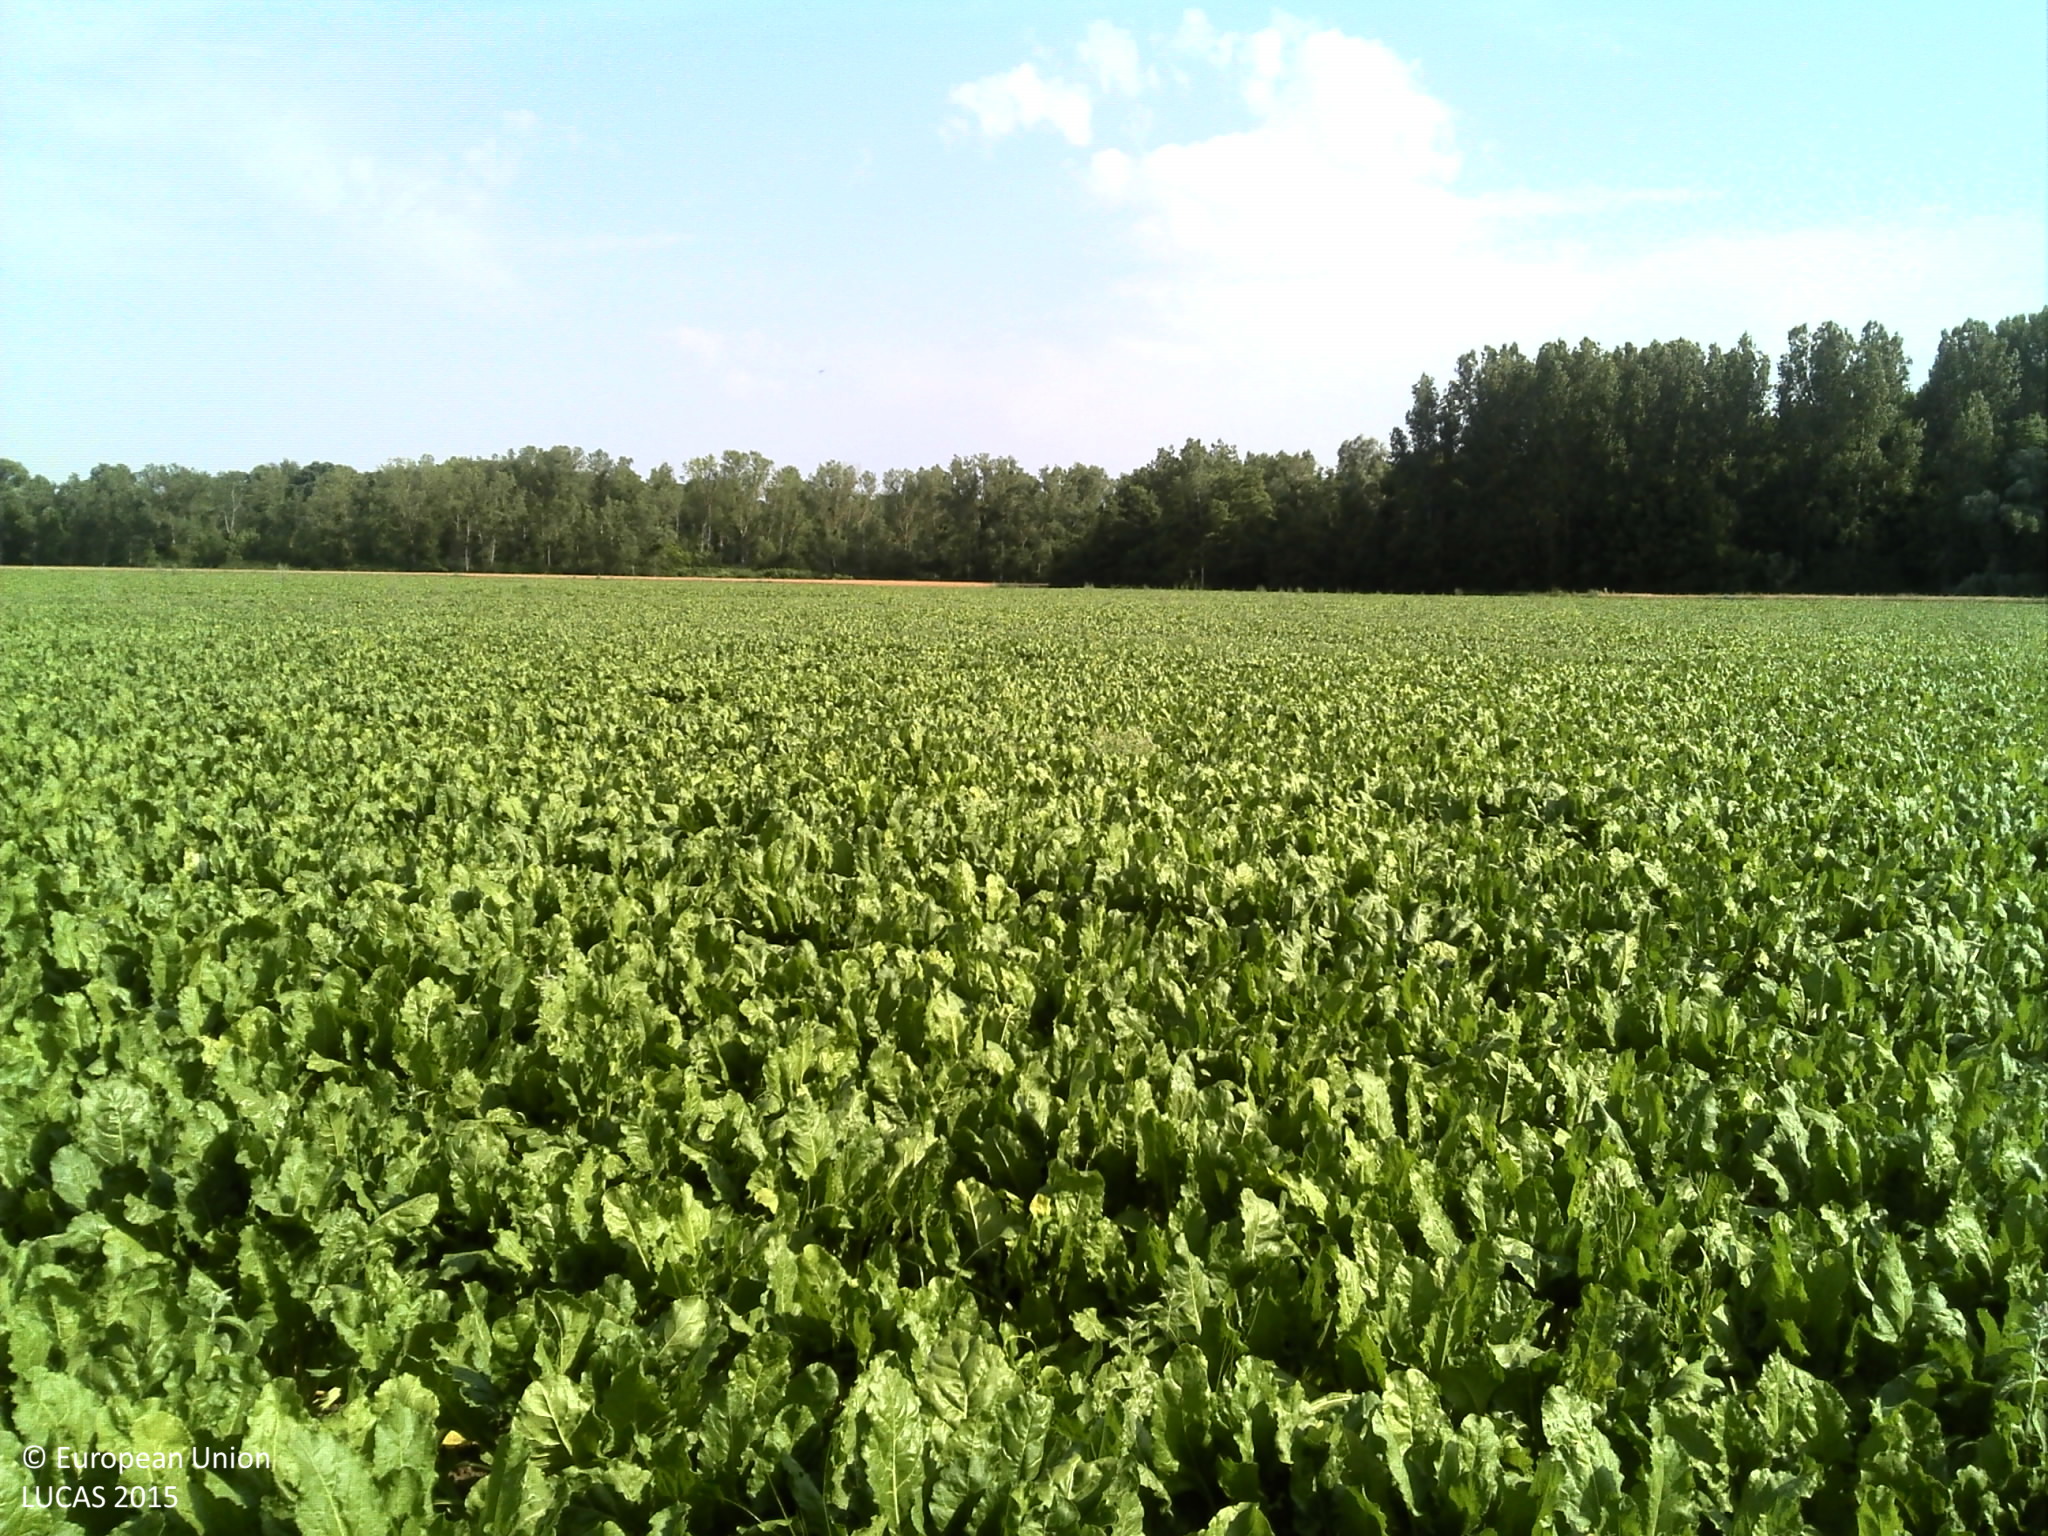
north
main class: Cropland
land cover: Maize
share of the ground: > 75 %
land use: Agriculture (excluding fallow land and kitchen gardens)
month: July
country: FR
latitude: 45.8708
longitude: 3.3141
